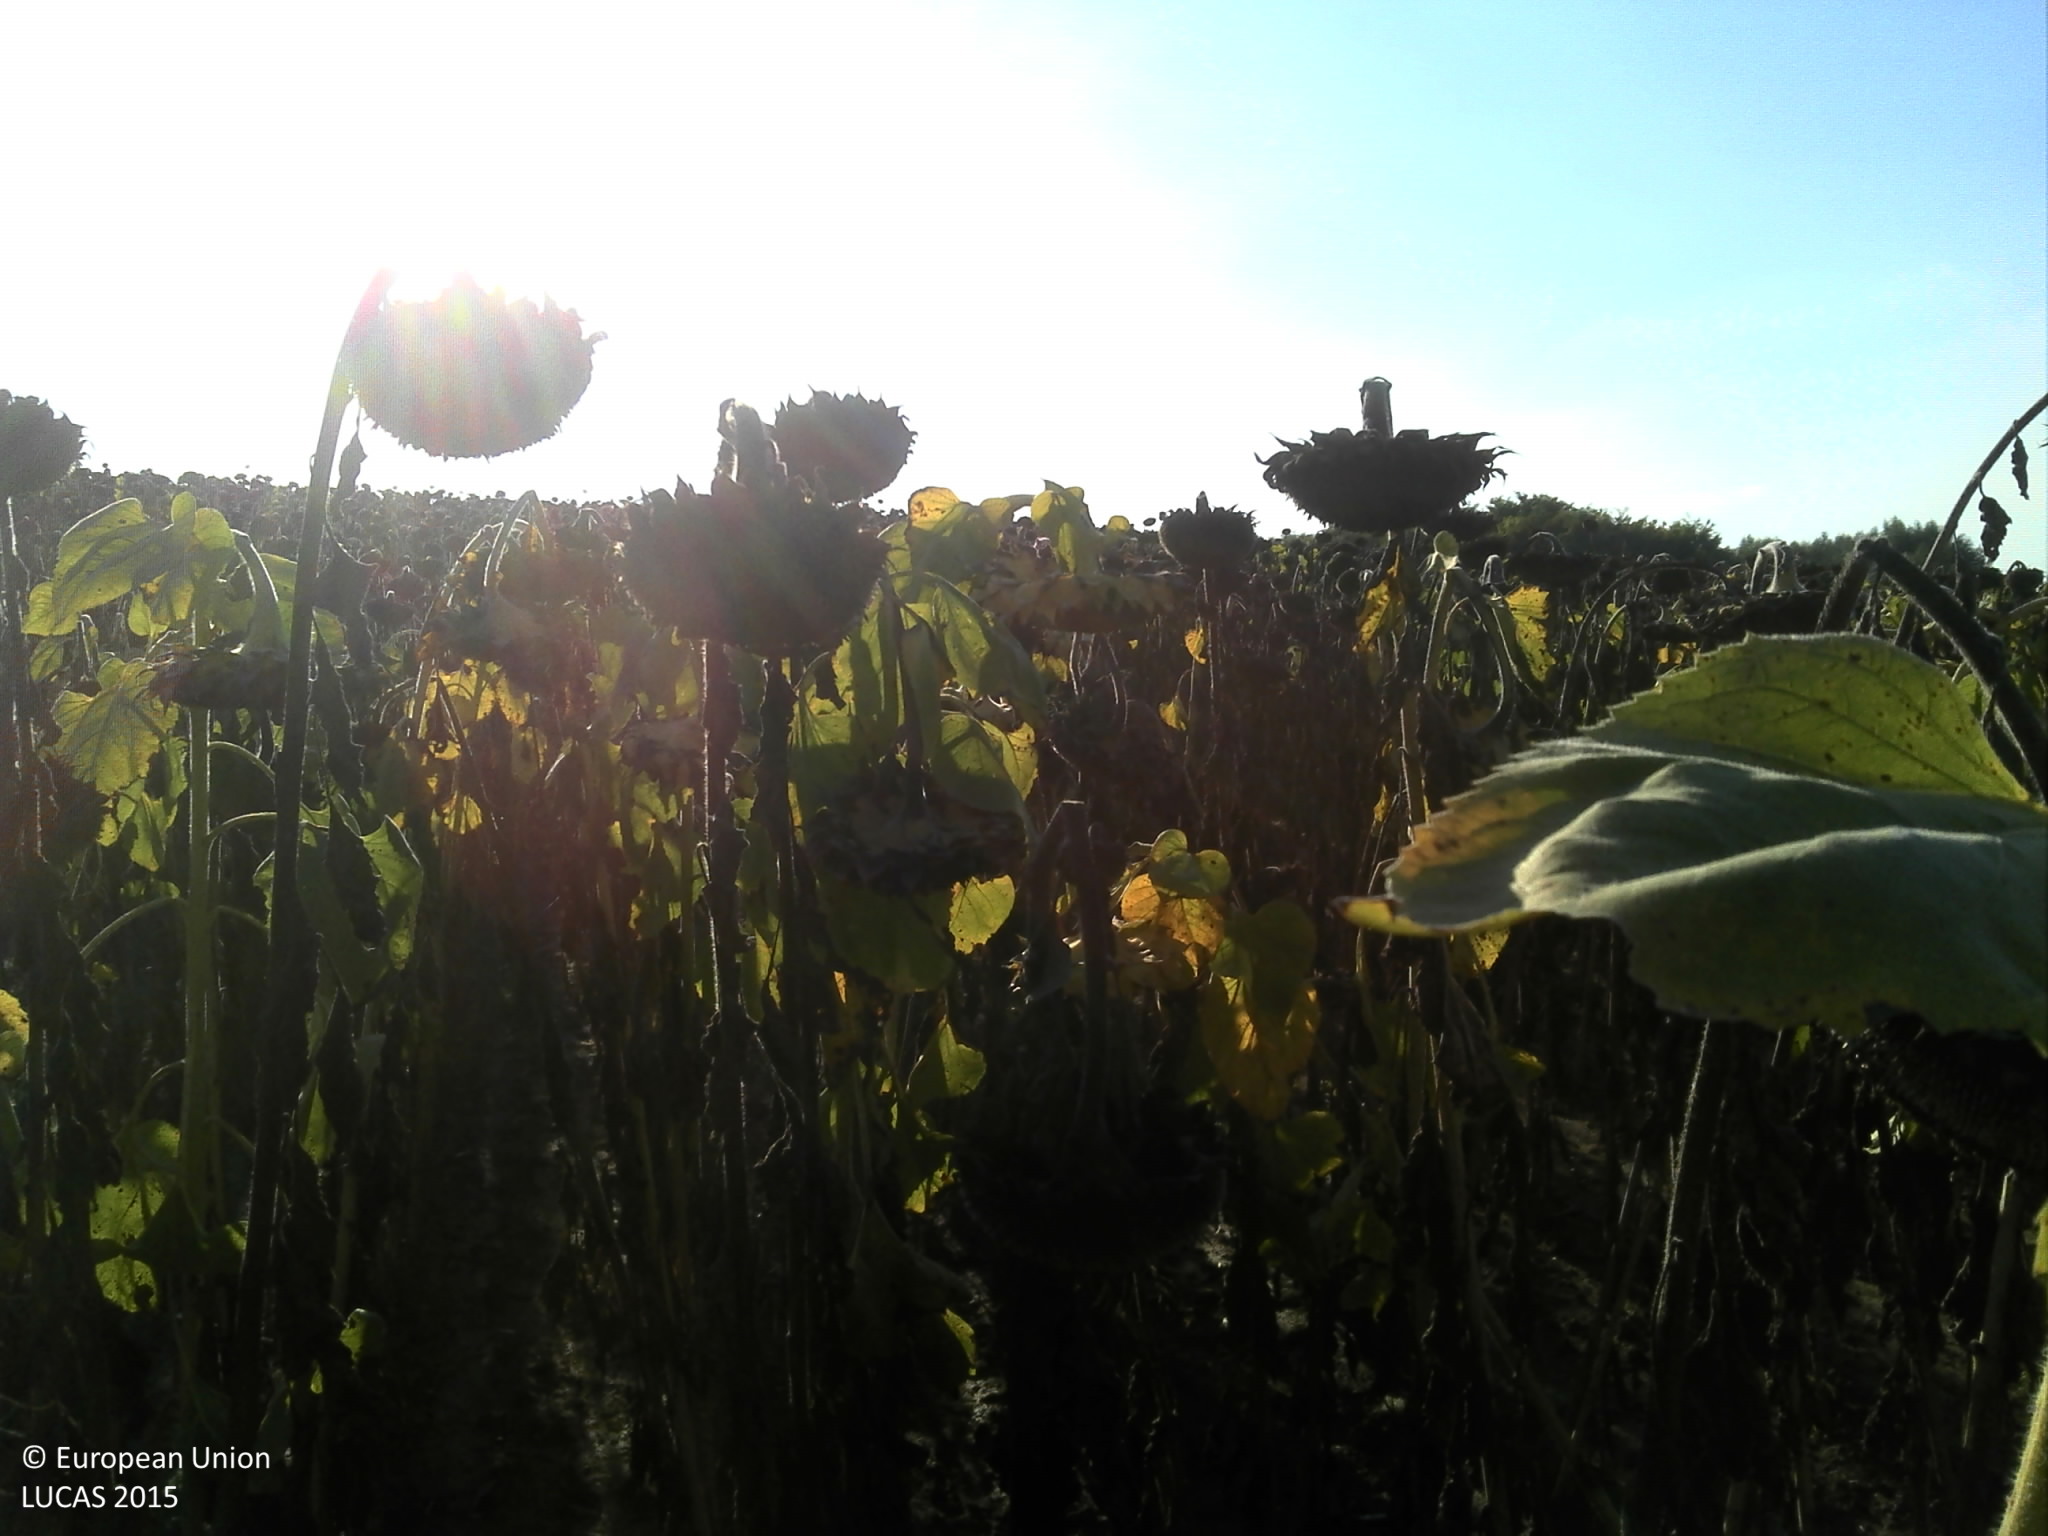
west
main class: Cropland
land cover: Sunflower
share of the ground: > 75 %
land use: Agriculture (excluding fallow land and kitchen gardens)
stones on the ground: < 10 %
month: September
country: HR
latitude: 45.3408
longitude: 18.9544
